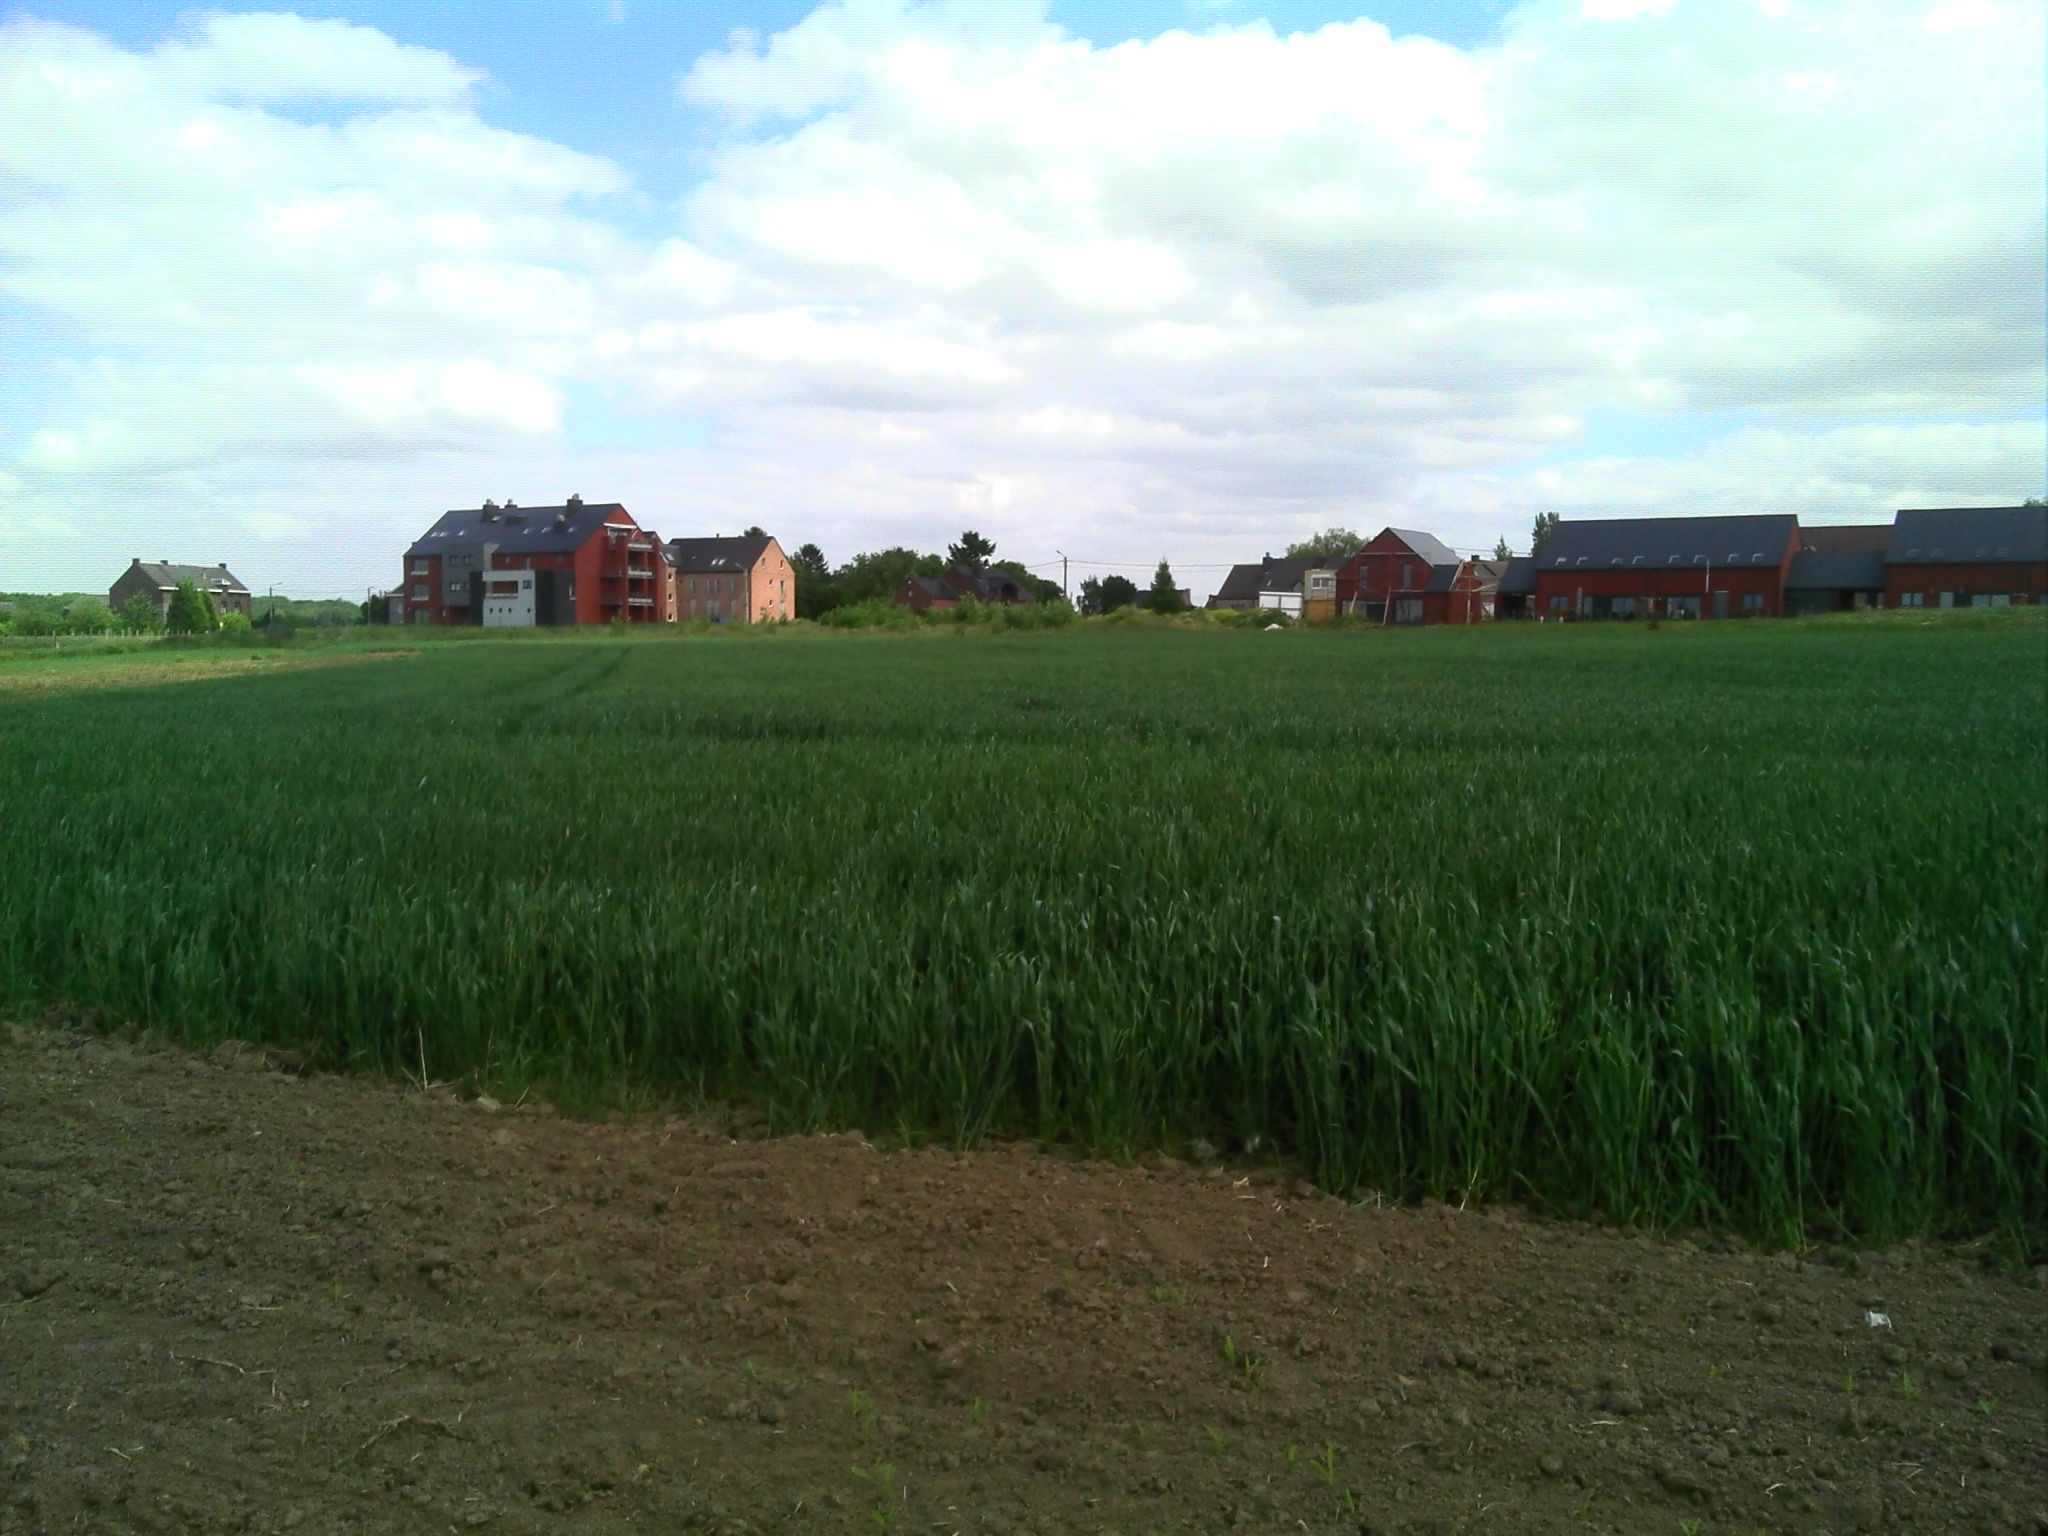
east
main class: Cropland
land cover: Maize
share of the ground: < 10 %
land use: Agriculture (excluding fallow land and kitchen gardens)
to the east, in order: Maize; Common wheat; Spontaneously vegetated surfaces; Paved roads, cycling and walking lanes; Electric lines; Artificial constructions in urban areas; Grassland without tree/shrub cover
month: June
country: BE
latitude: 50.4721
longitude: 4.6279
